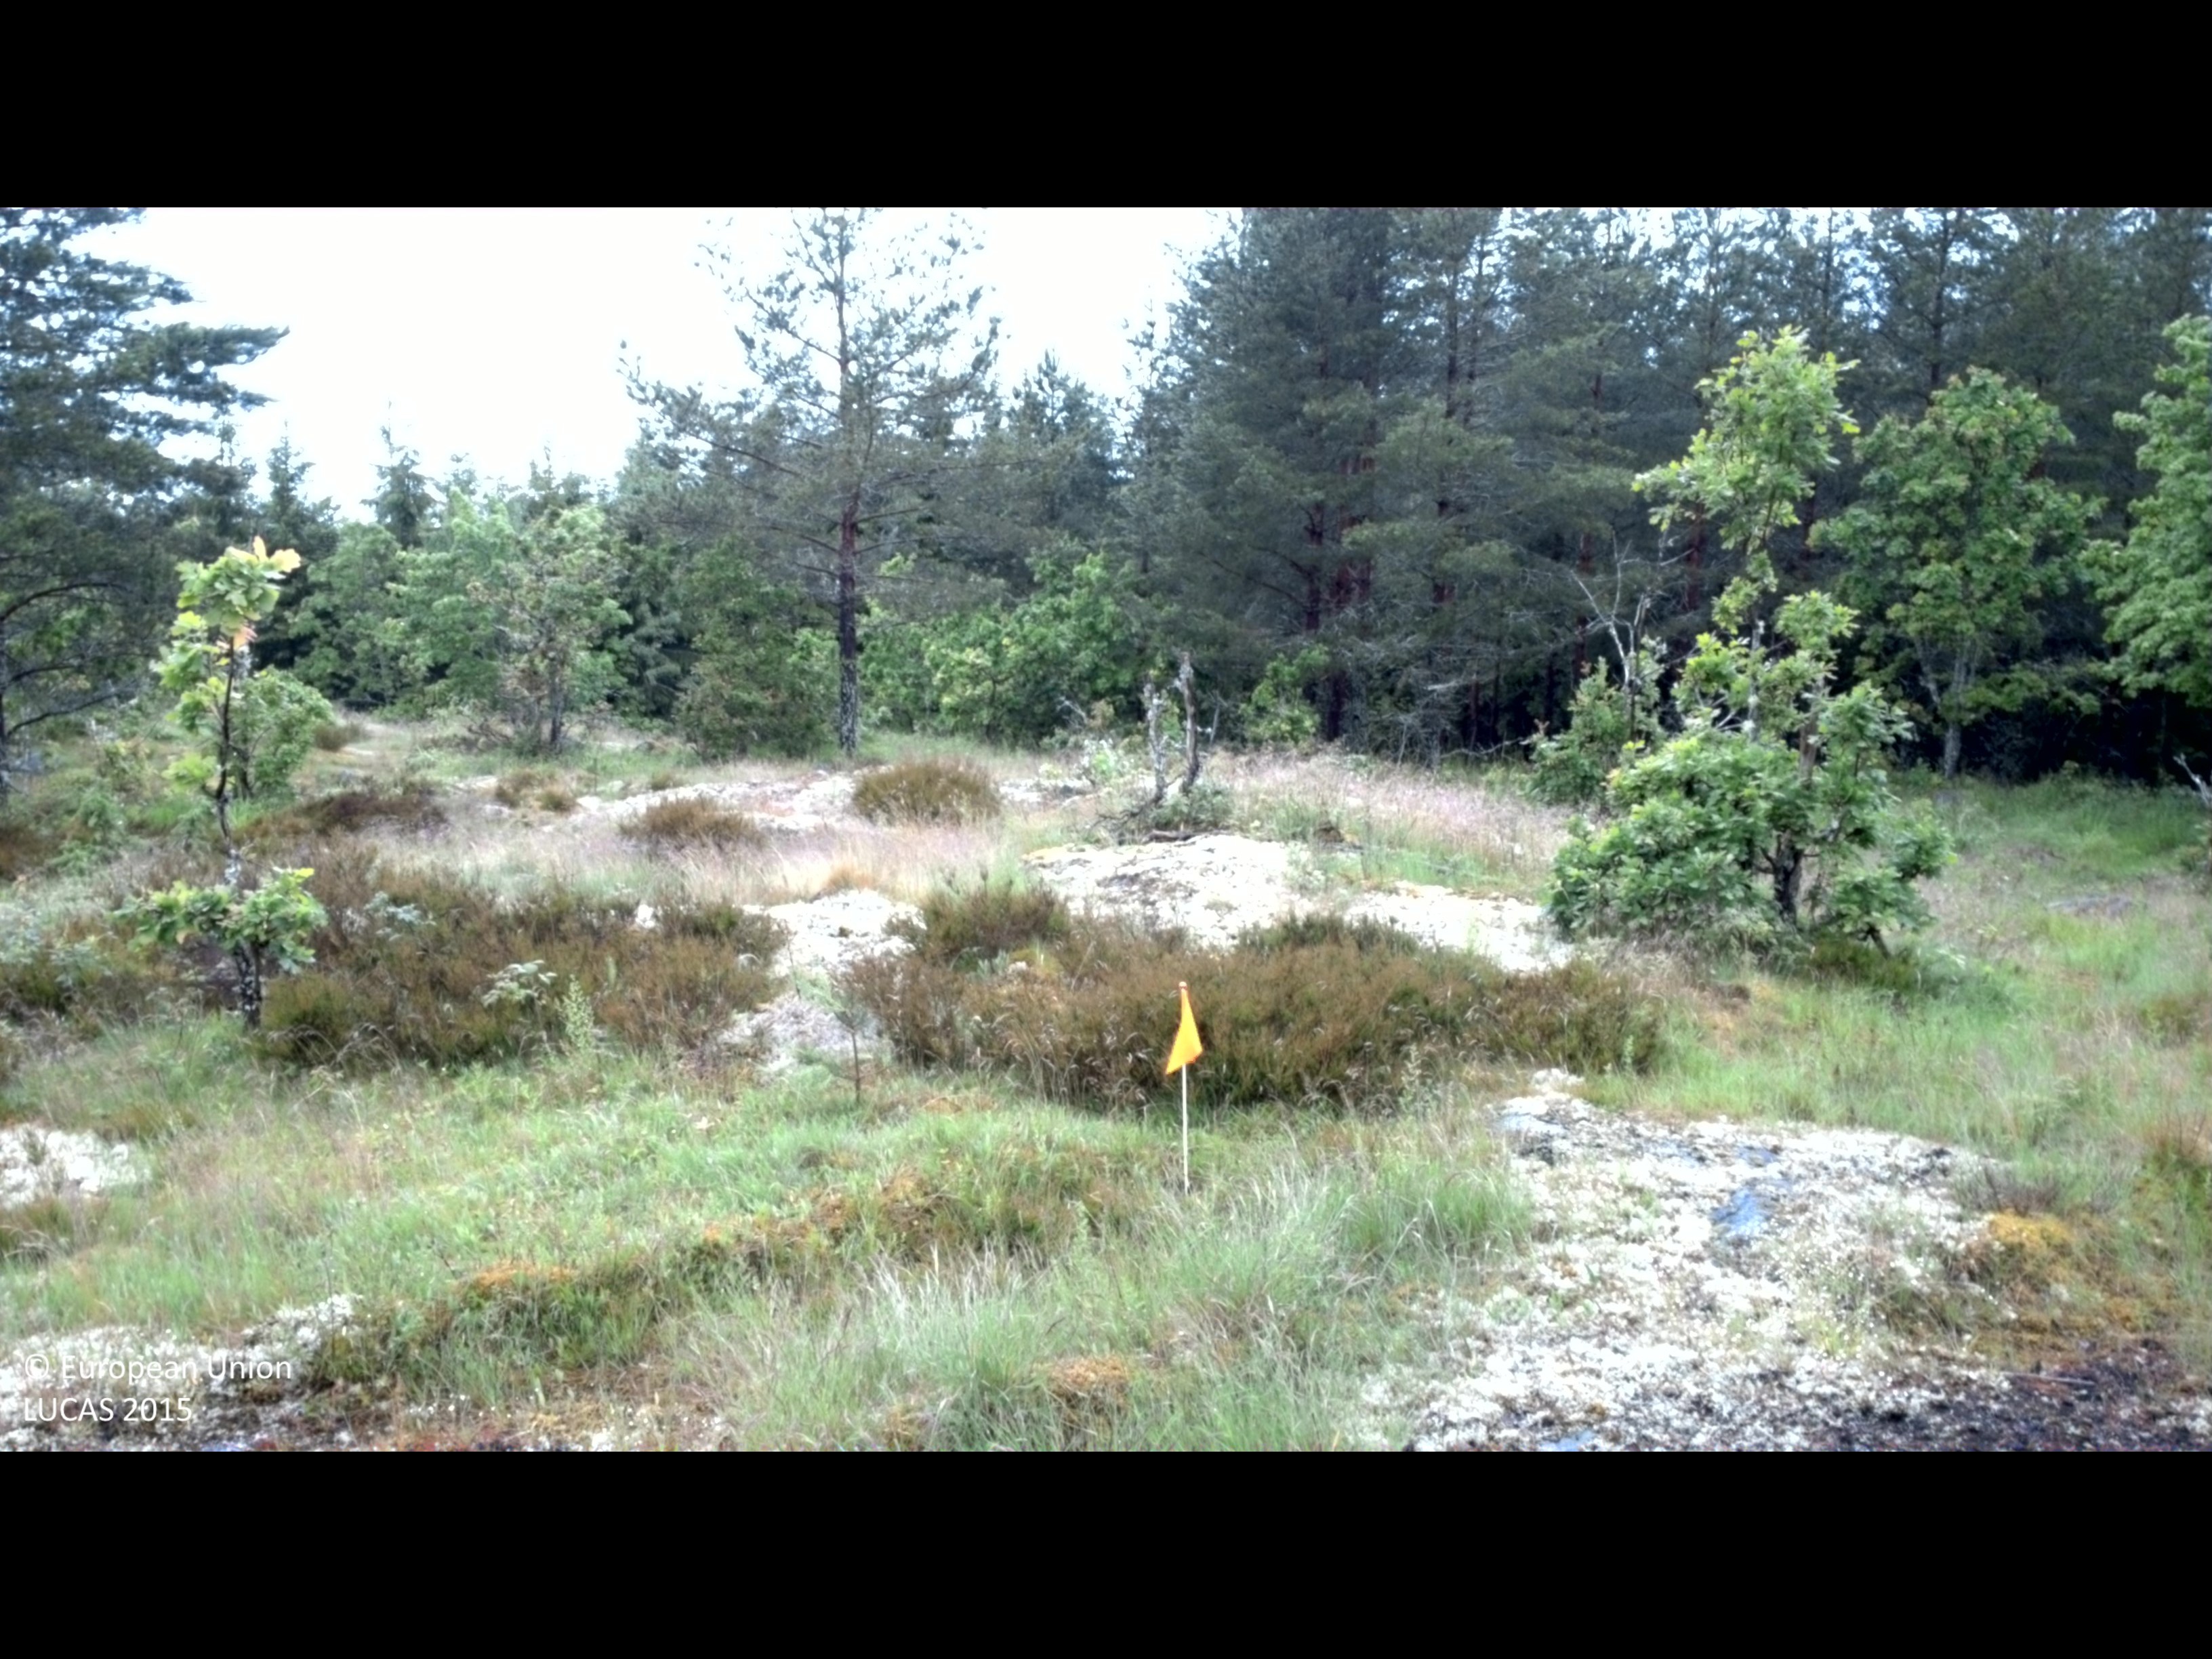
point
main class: Woodland
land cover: Pine dominated mixed woodland
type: boreal forest
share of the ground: 10 - 25 %
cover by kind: shrubs 50 %, lichens and mosses 25 %, coniferous forest trees 10 %, herbaceous plants 10 %, broadleaved forest trees 5 %
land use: Semi-natural and natural areas not in use
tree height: > 5 m
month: June
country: SE
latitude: 57.9993
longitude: 16.3079
